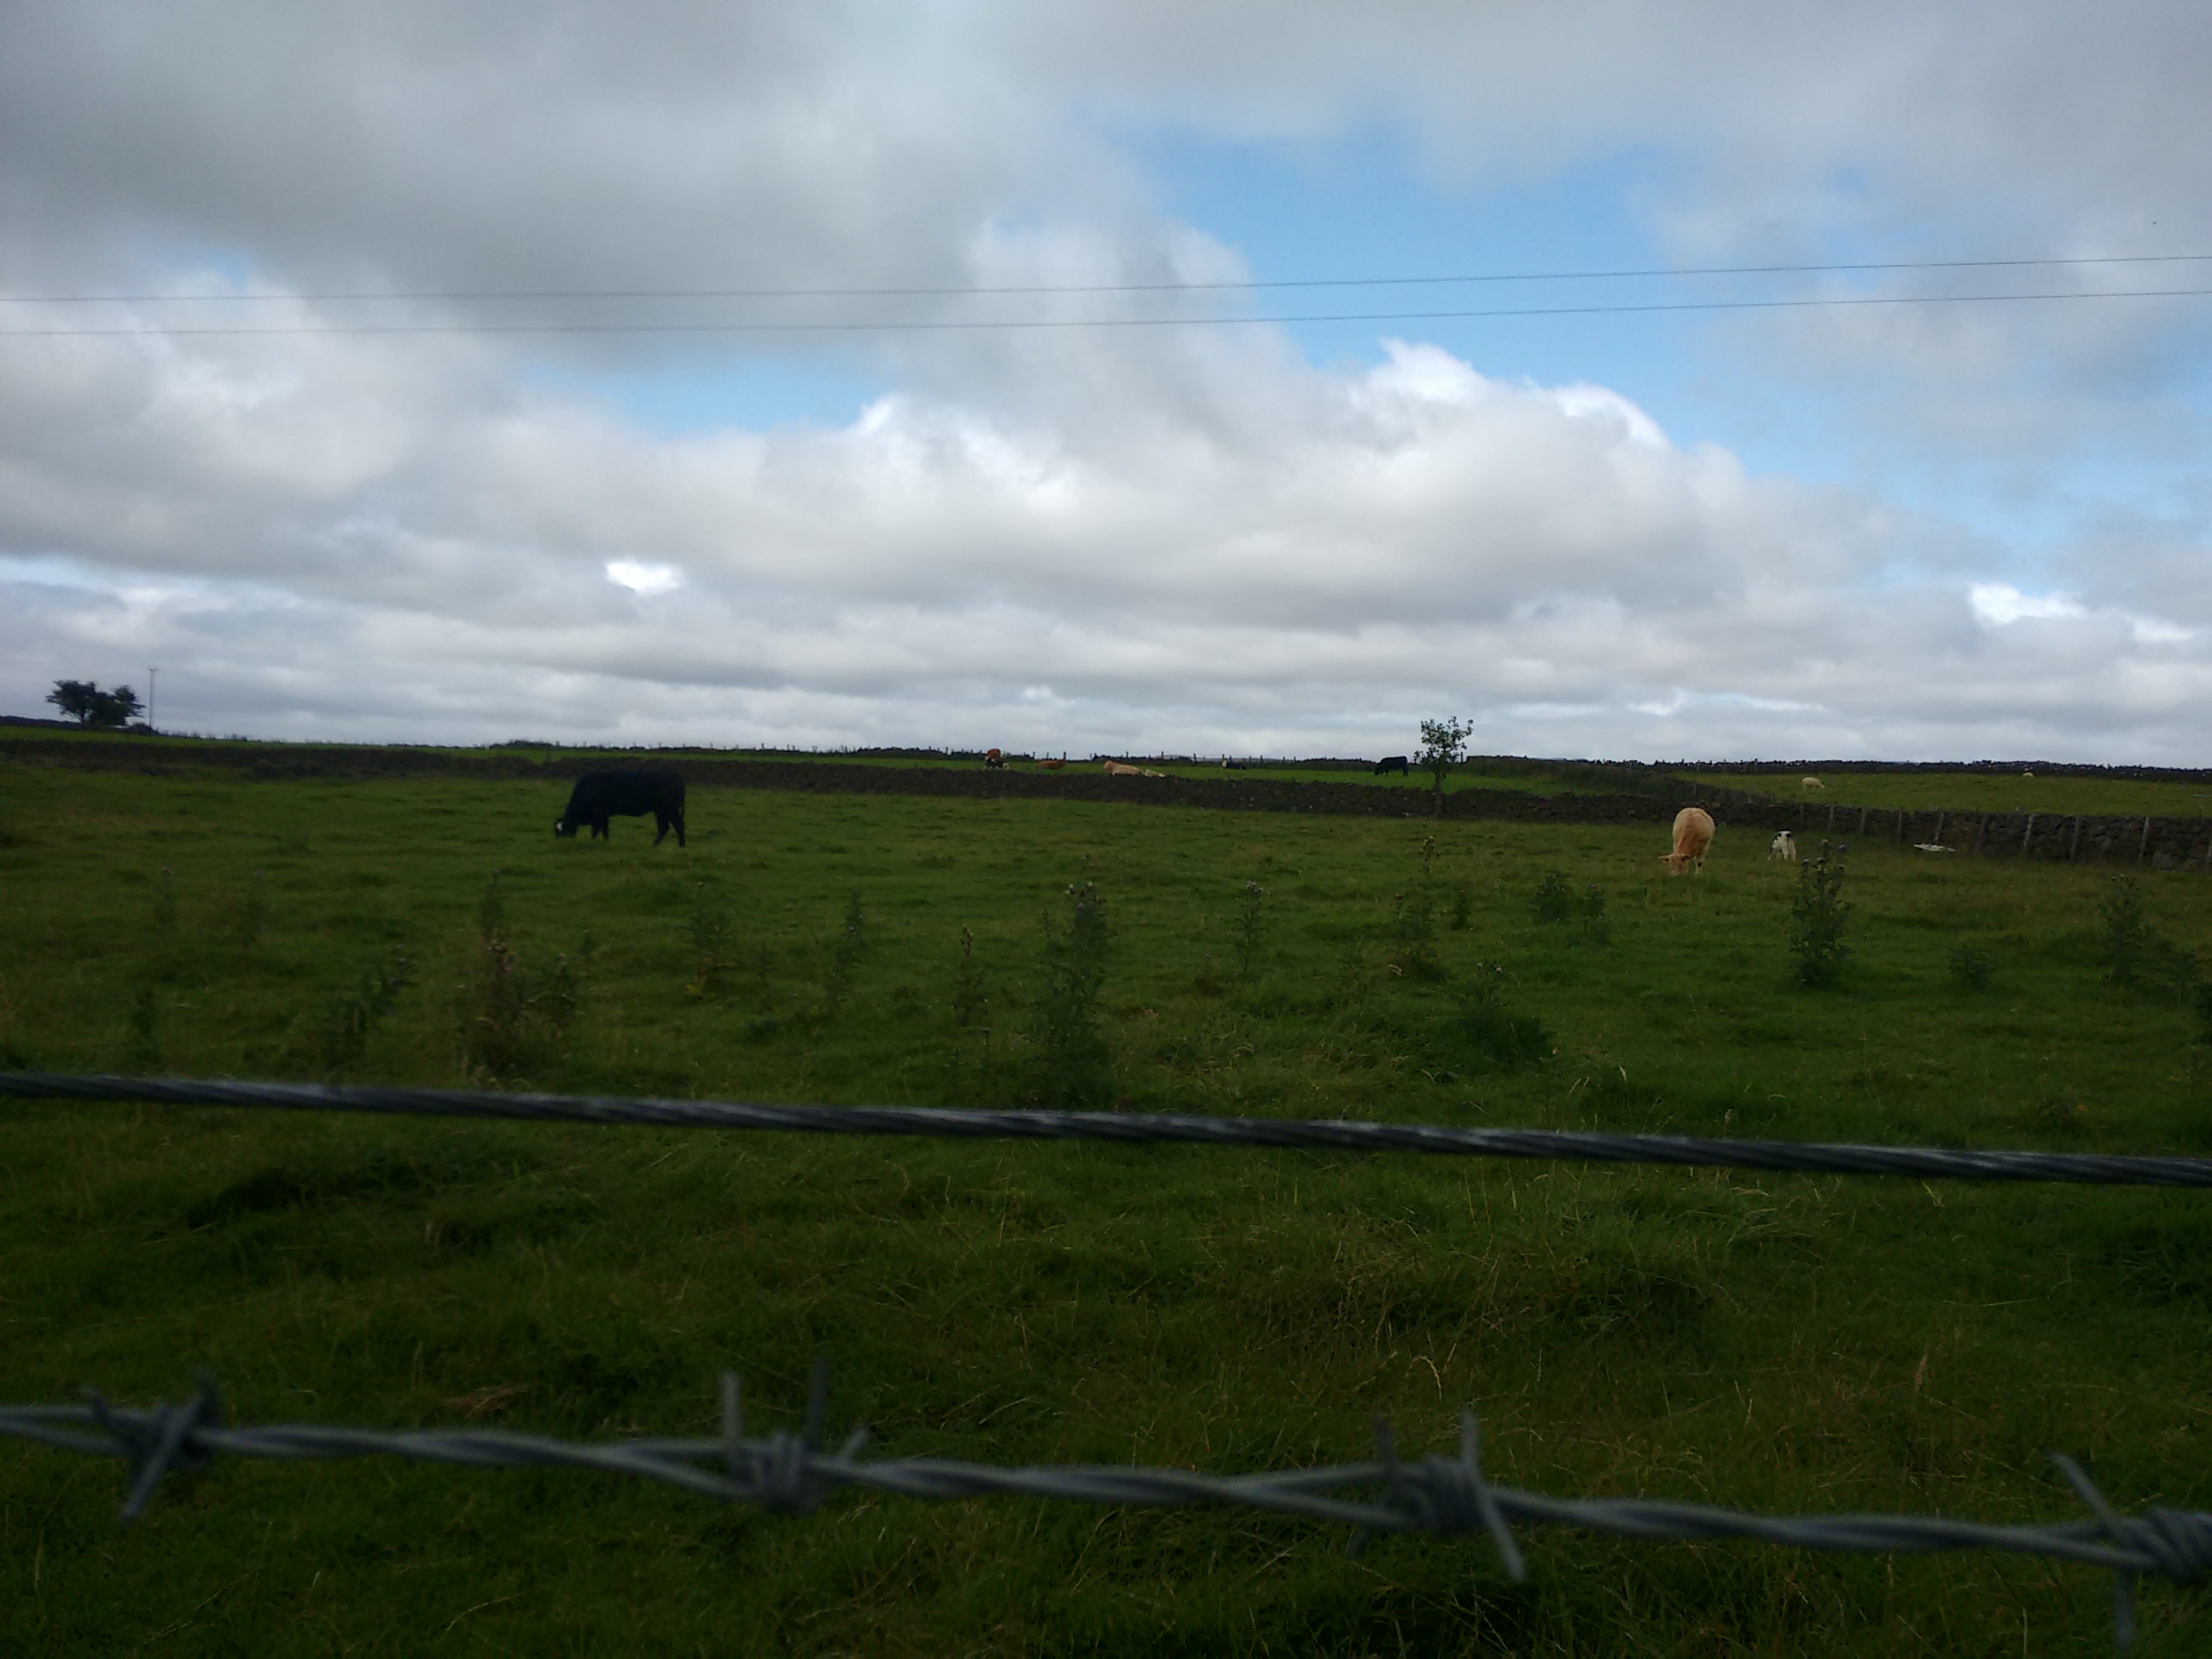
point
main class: Grassland
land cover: Grassland without tree/shrub cover
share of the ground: > 75 %
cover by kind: herbaceous plants 100 %
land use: Agriculture (excluding fallow land and kitchen gardens)
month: September
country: GB
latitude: 54.9081
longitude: -6.0665
